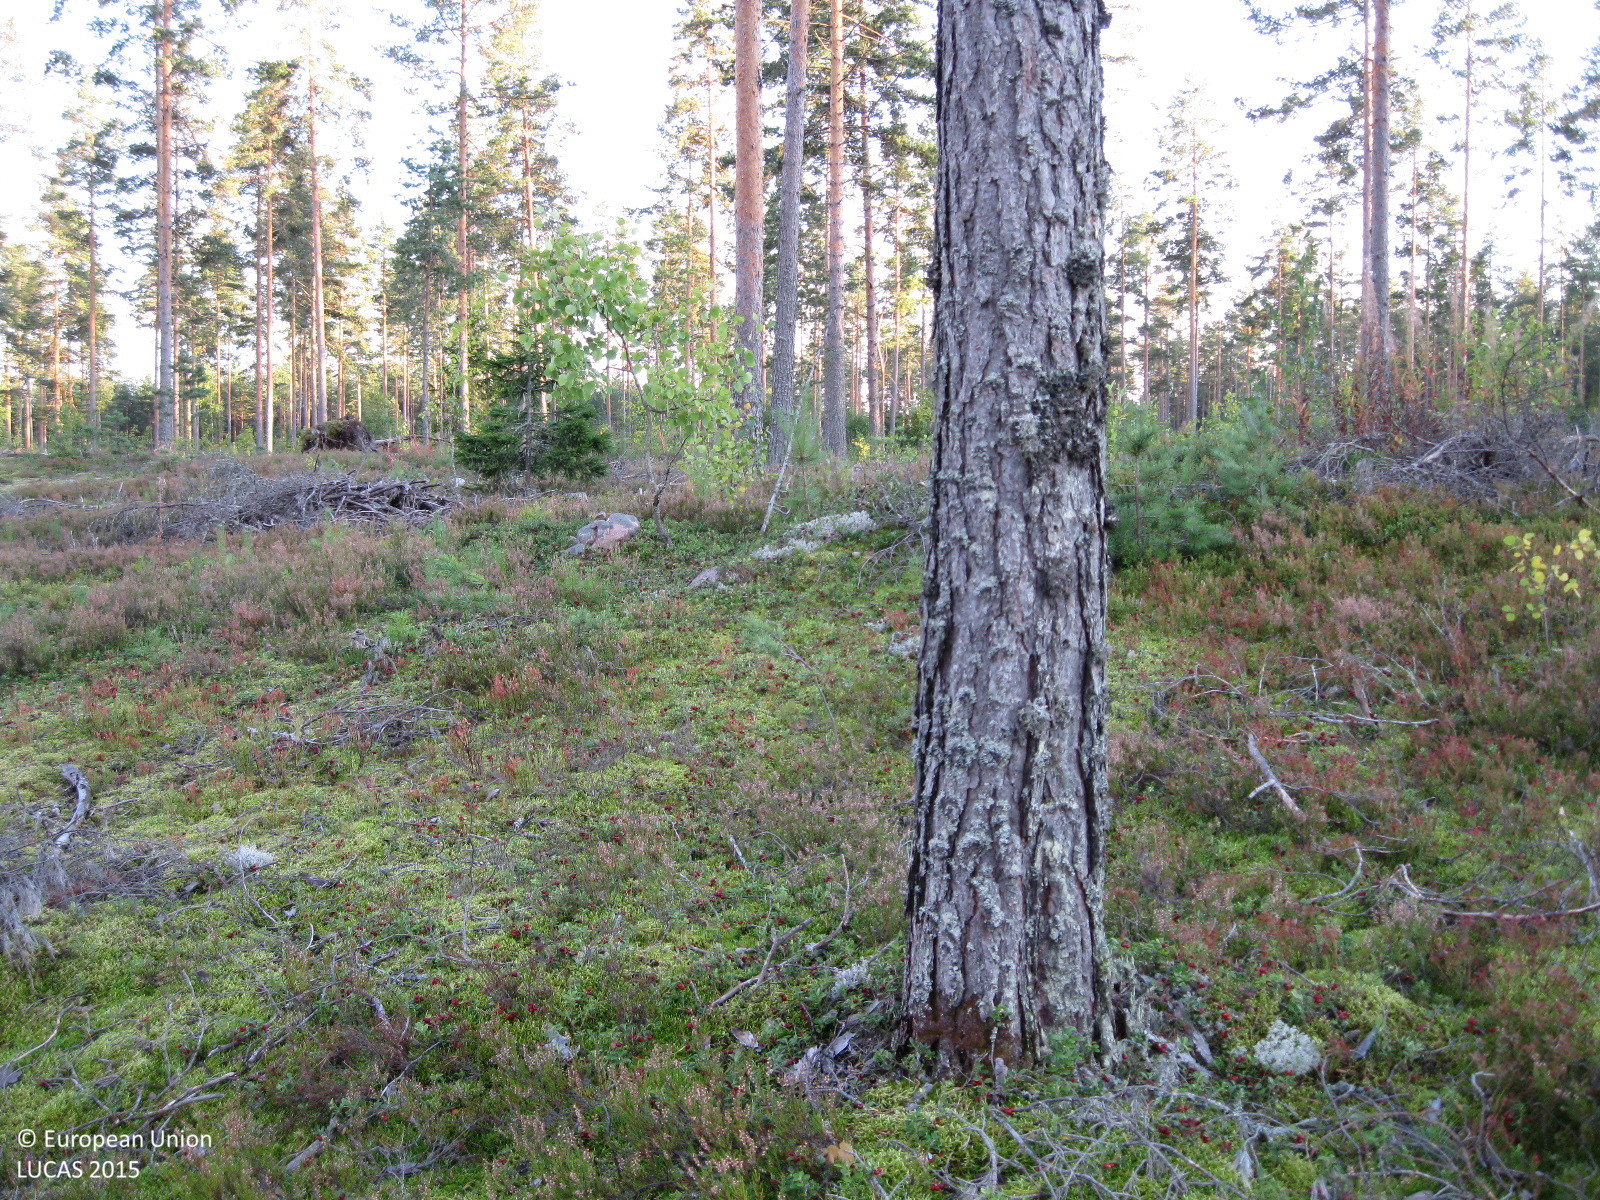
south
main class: Woodland
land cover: Pine dominated coniferous woodland
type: boreal forest
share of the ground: 25 - 50 %
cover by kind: shrubs 45 %, coniferous forest trees 25 %, lichens and mosses 25 %, broadleaved forest trees 5 %
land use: Forestry
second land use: Amenities, museums, leisure
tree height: > 5 m
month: September
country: FI
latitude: 60.5066
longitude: 24.6961
